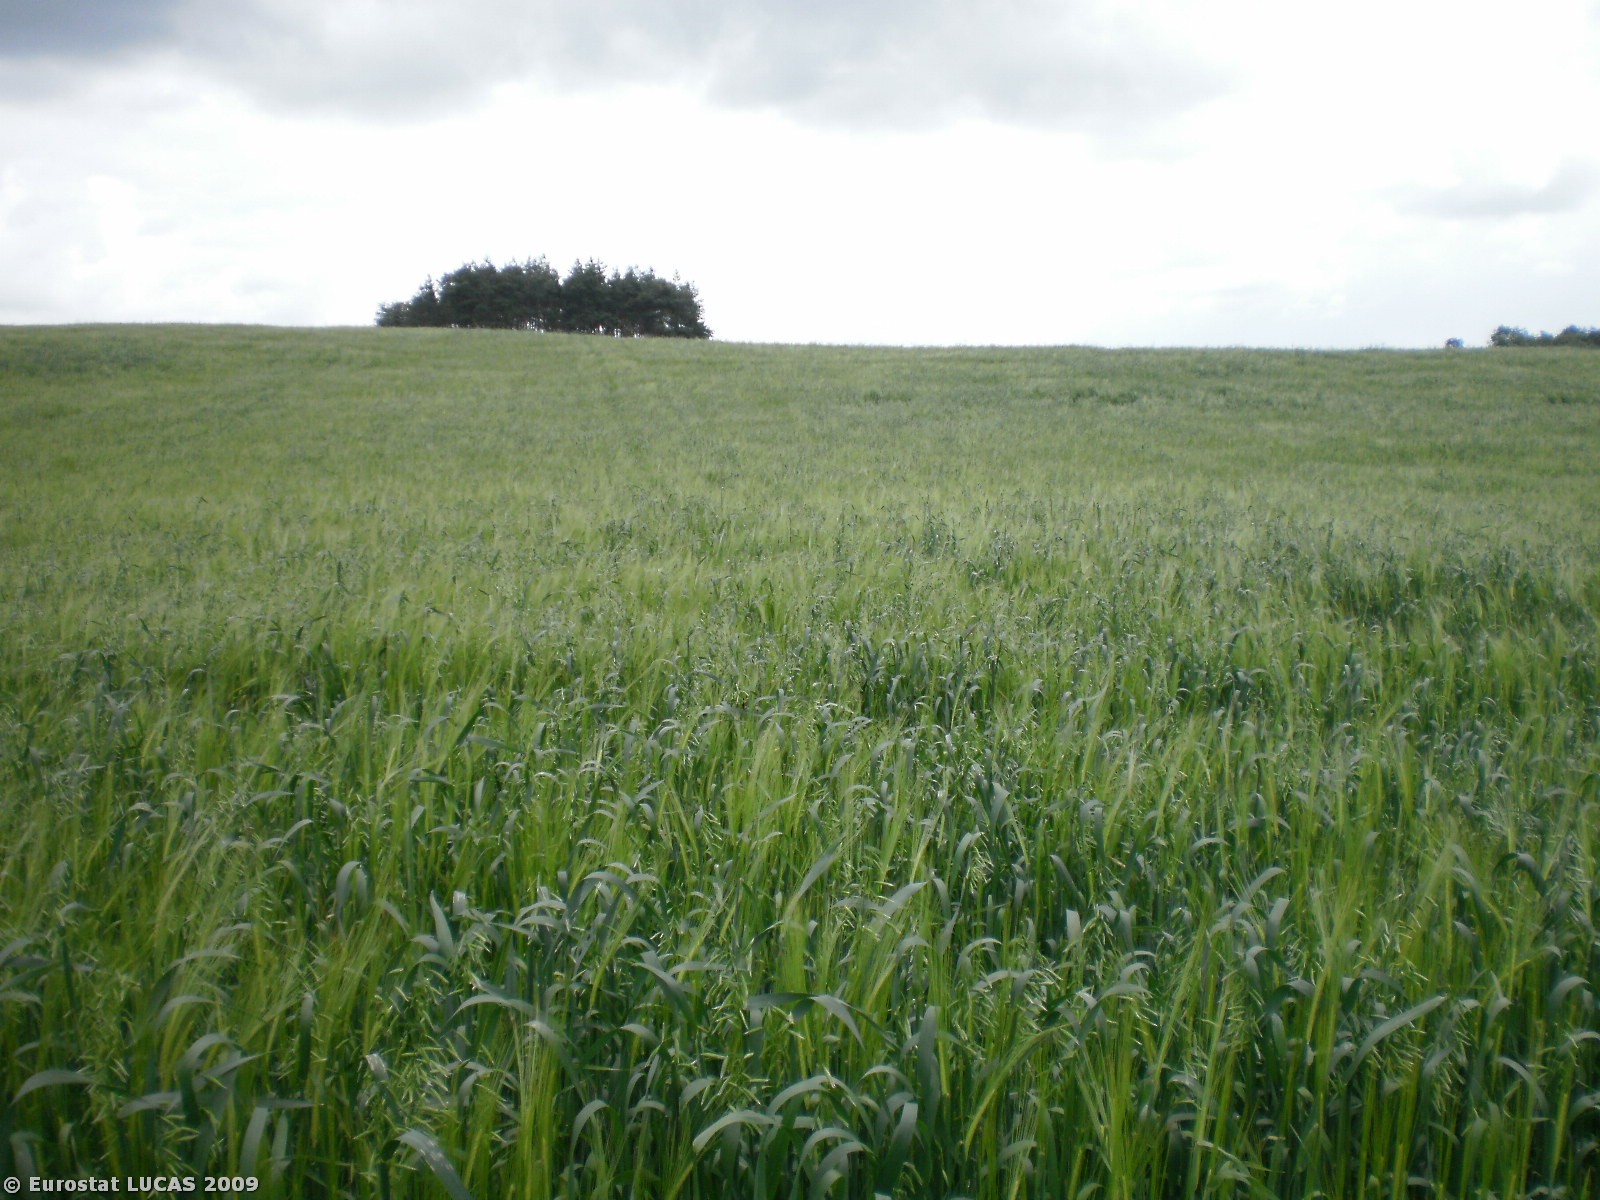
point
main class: Cropland
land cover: Mixed cereals for fodder
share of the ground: > 75 %
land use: Agriculture (excluding fallow land and kitchen gardens)
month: June
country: PL
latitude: 53.4383
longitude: 19.7995
